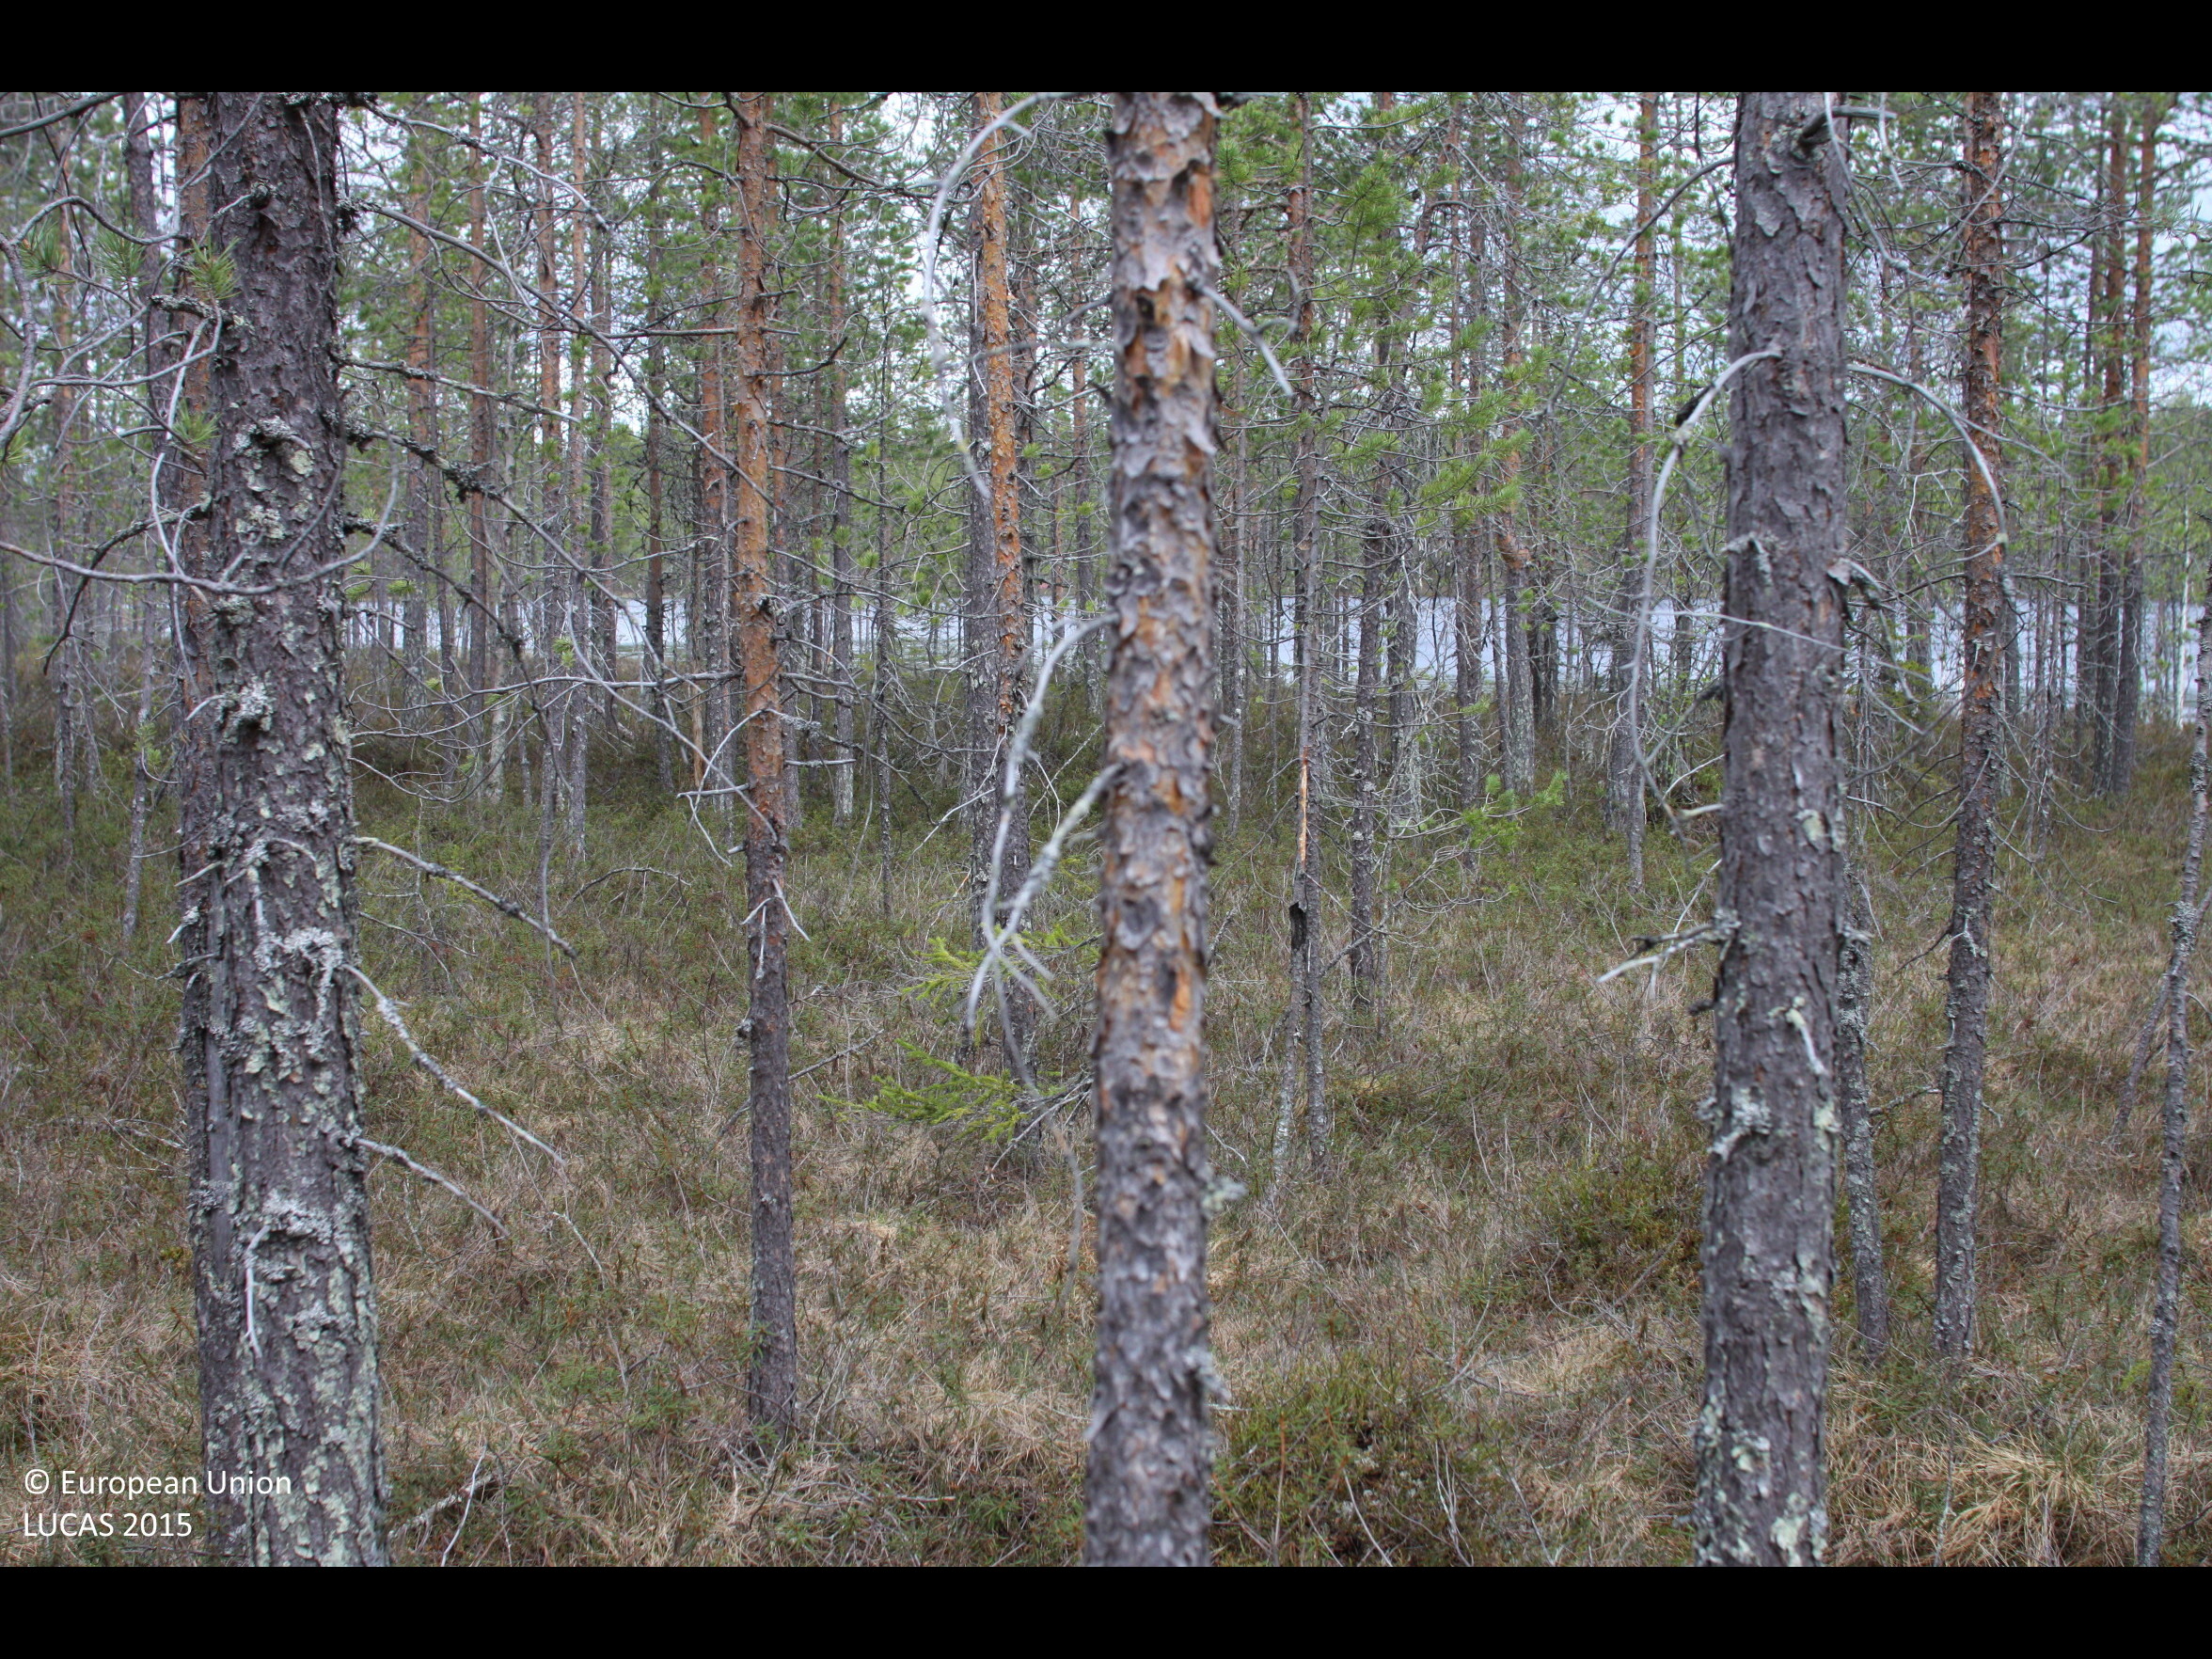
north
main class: Woodland
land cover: Pine dominated coniferous woodland
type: boreal forest
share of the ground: 50 - 75 %
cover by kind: coniferous forest trees 65 %, shrubs 25 %, herbaceous plants 5 %, lichens and mosses 5 %
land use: Forestry
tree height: > 5 m
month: June
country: FI
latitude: 66.2052
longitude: 27.8776
